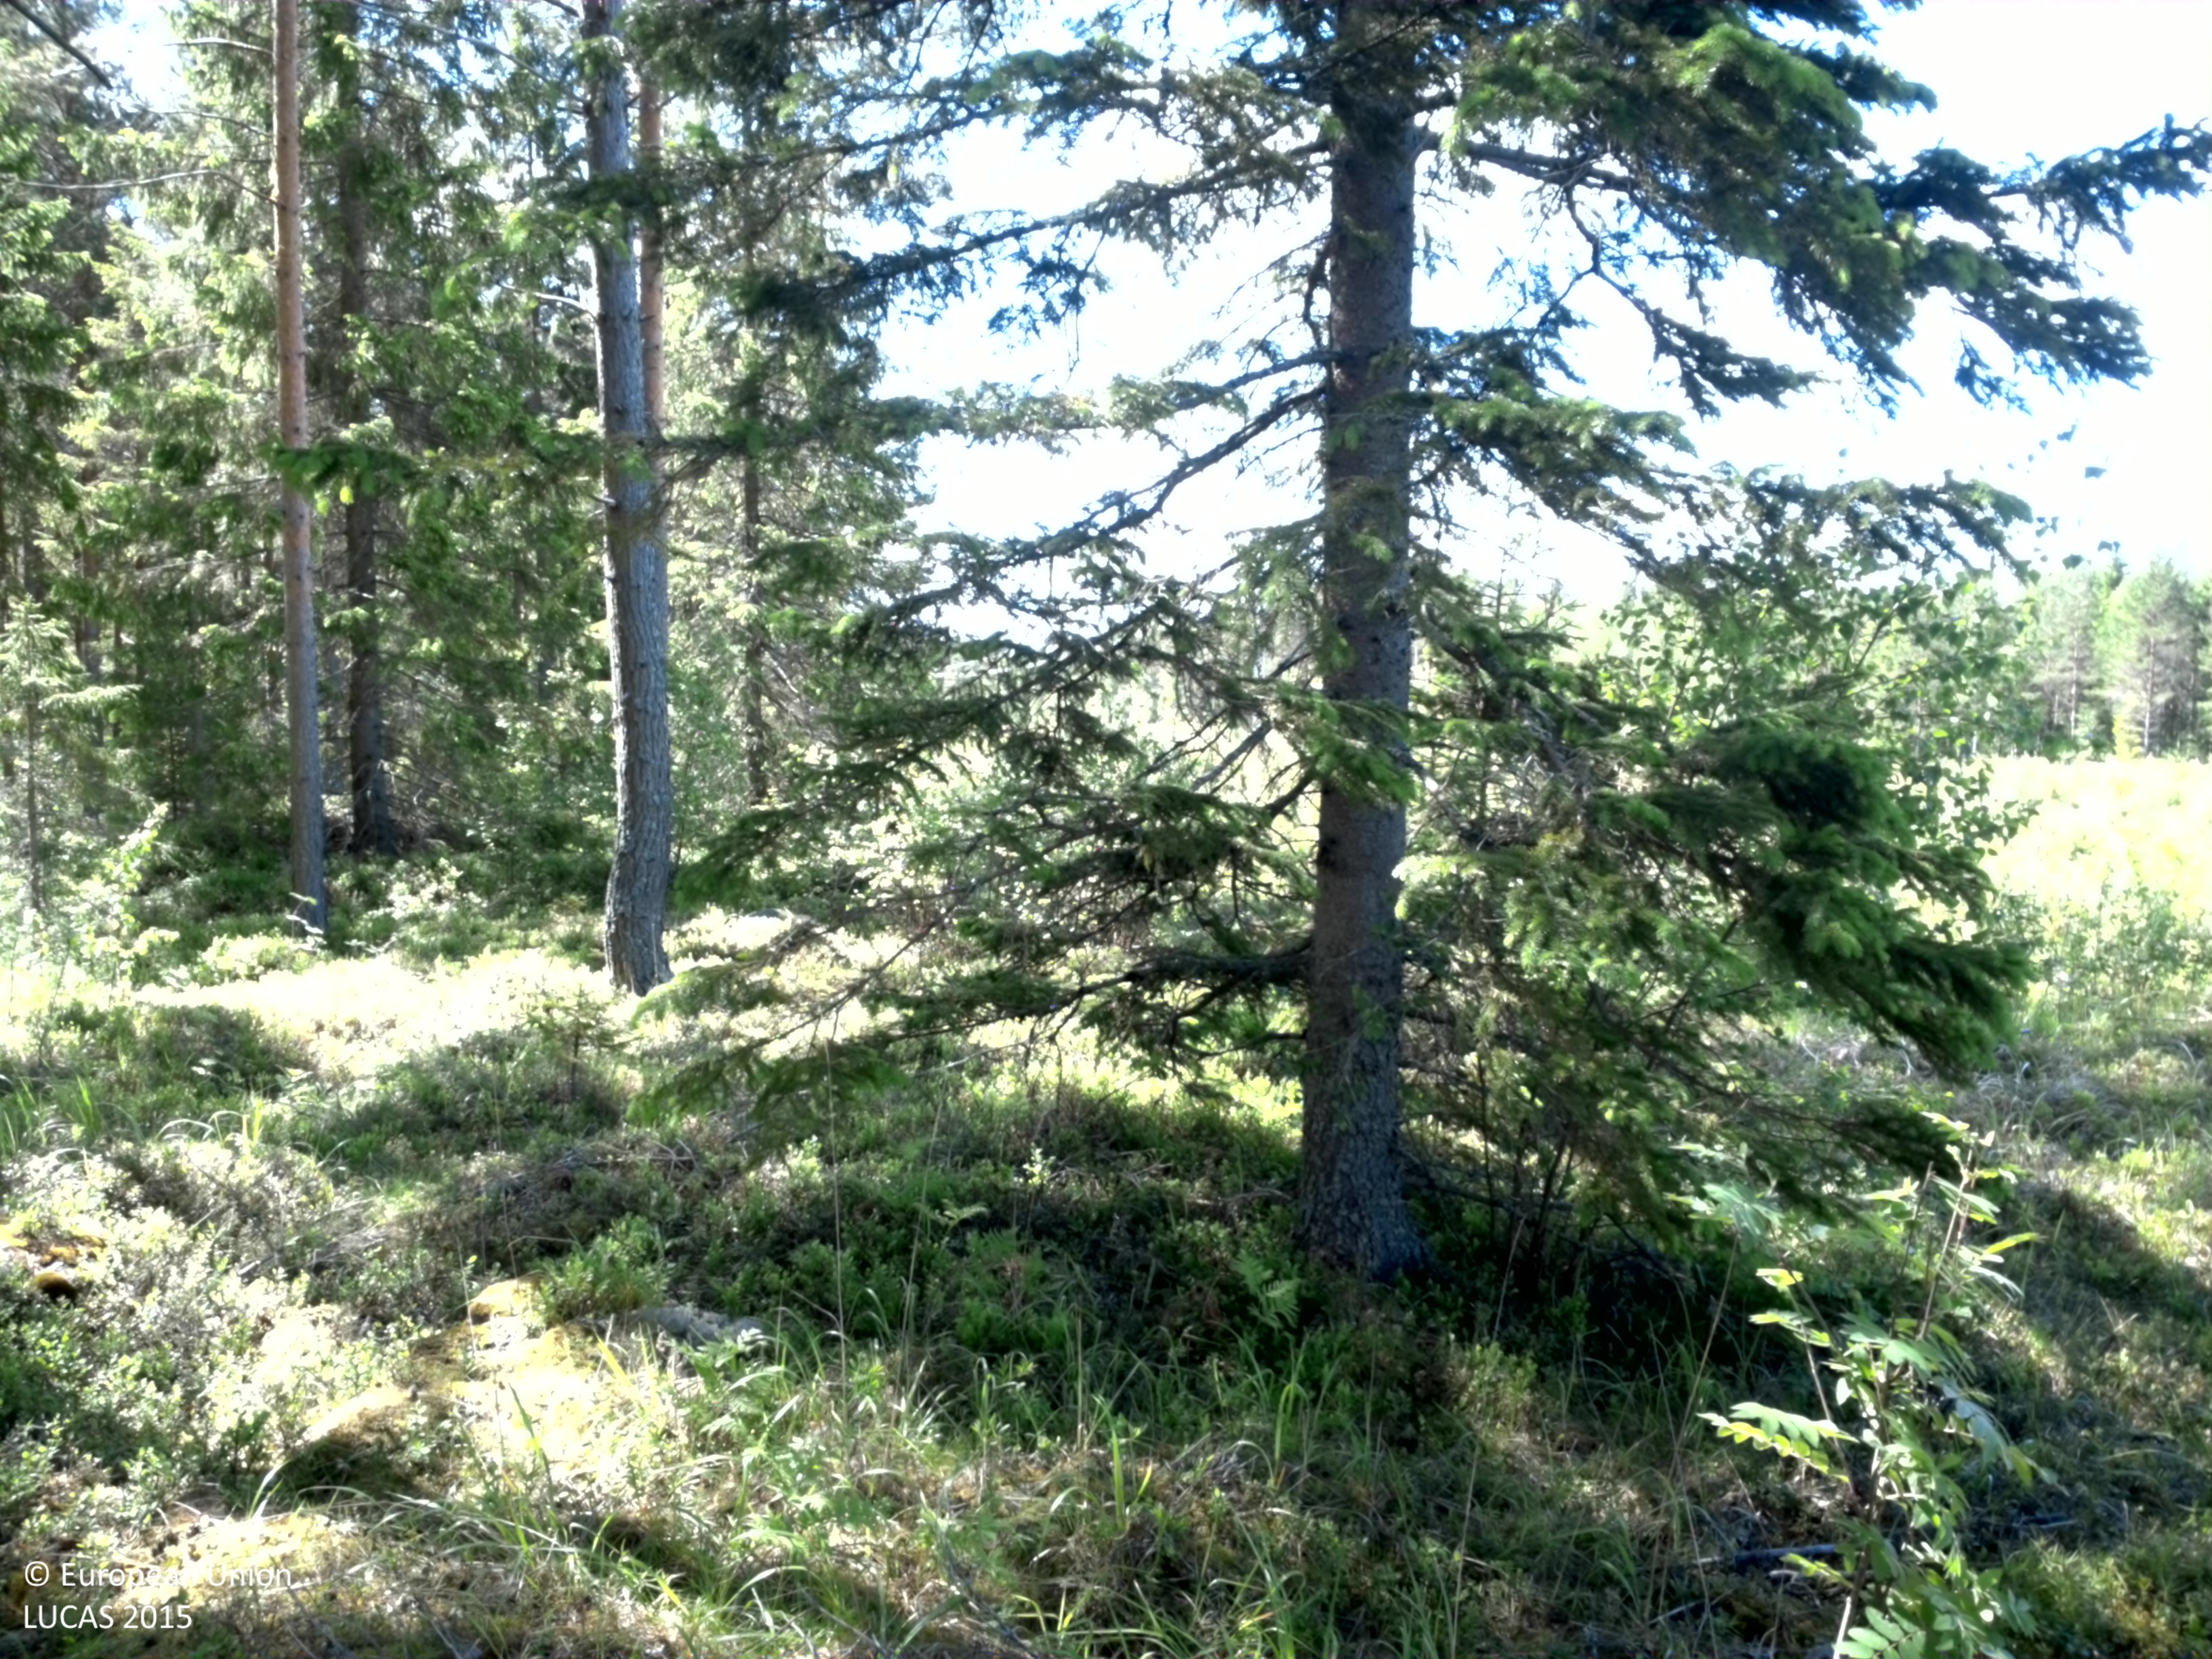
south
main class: Woodland
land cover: Spruce dominated mixed woodland
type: boreal forest
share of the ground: 50 - 75 %
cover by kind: coniferous forest trees 45 %, herbaceous plants 30 %, broadleaved forest trees 15 %, lichens and mosses 10 %
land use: Forestry
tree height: > 5 m
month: June
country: SE
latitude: 60.2554
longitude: 17.0922
